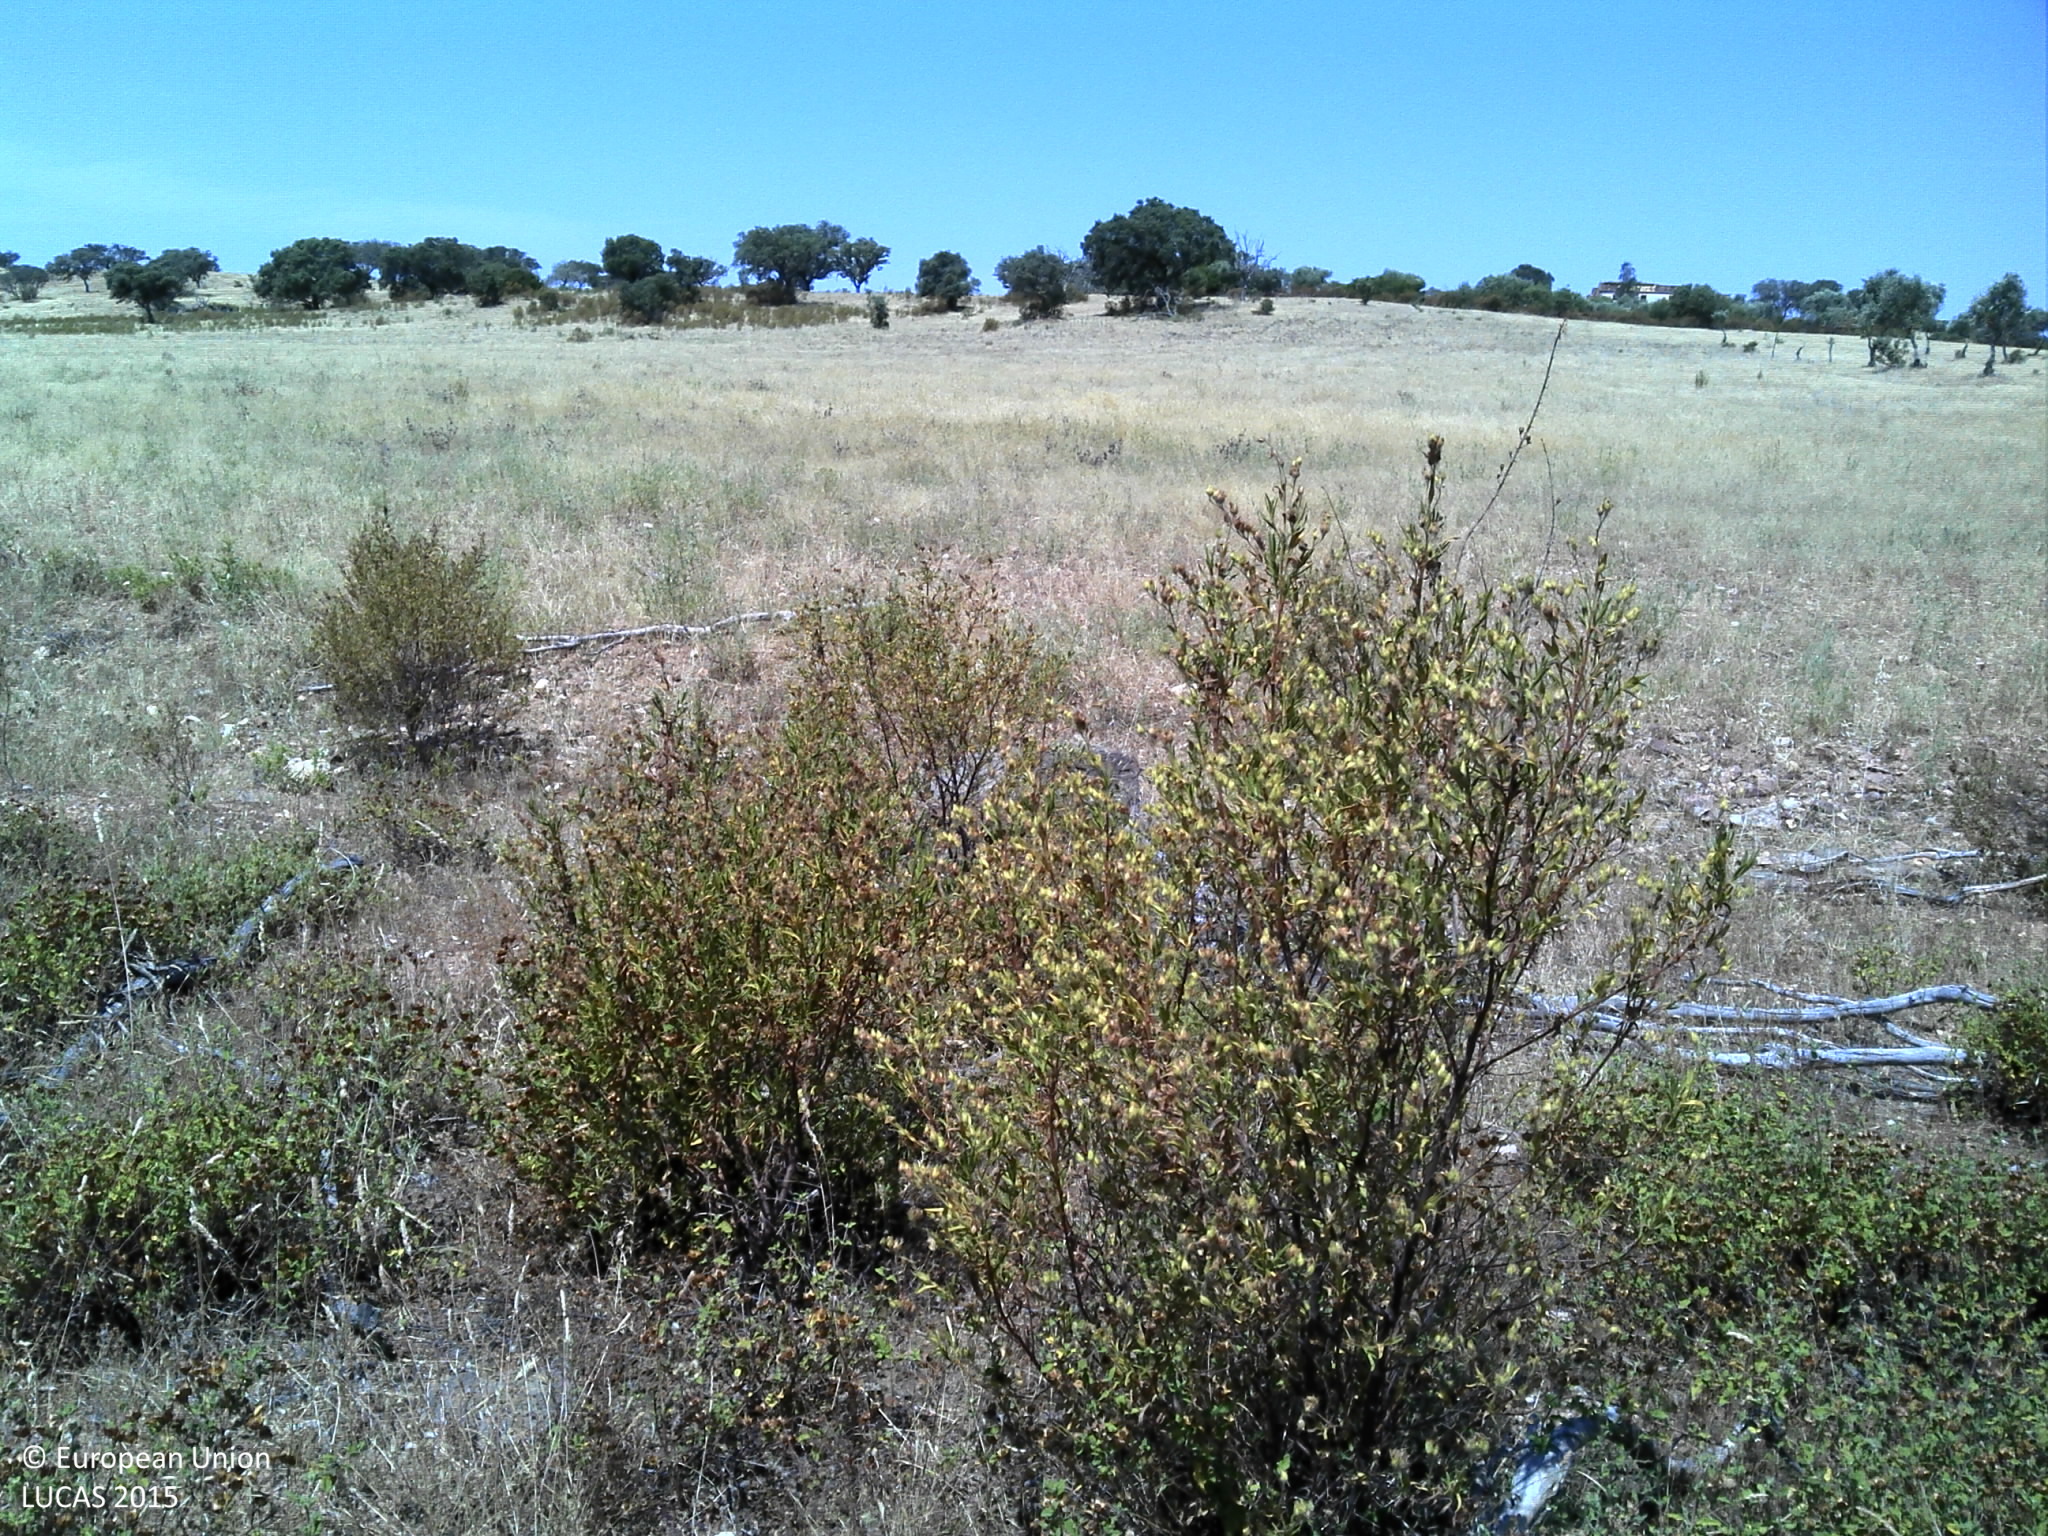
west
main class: Shrubland
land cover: Shrubland without tree cover
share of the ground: 50 - 75 %
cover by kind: shrubs 100 %
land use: Semi-natural and natural areas not in use
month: June
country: PT
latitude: 37.6948
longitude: -7.5359
